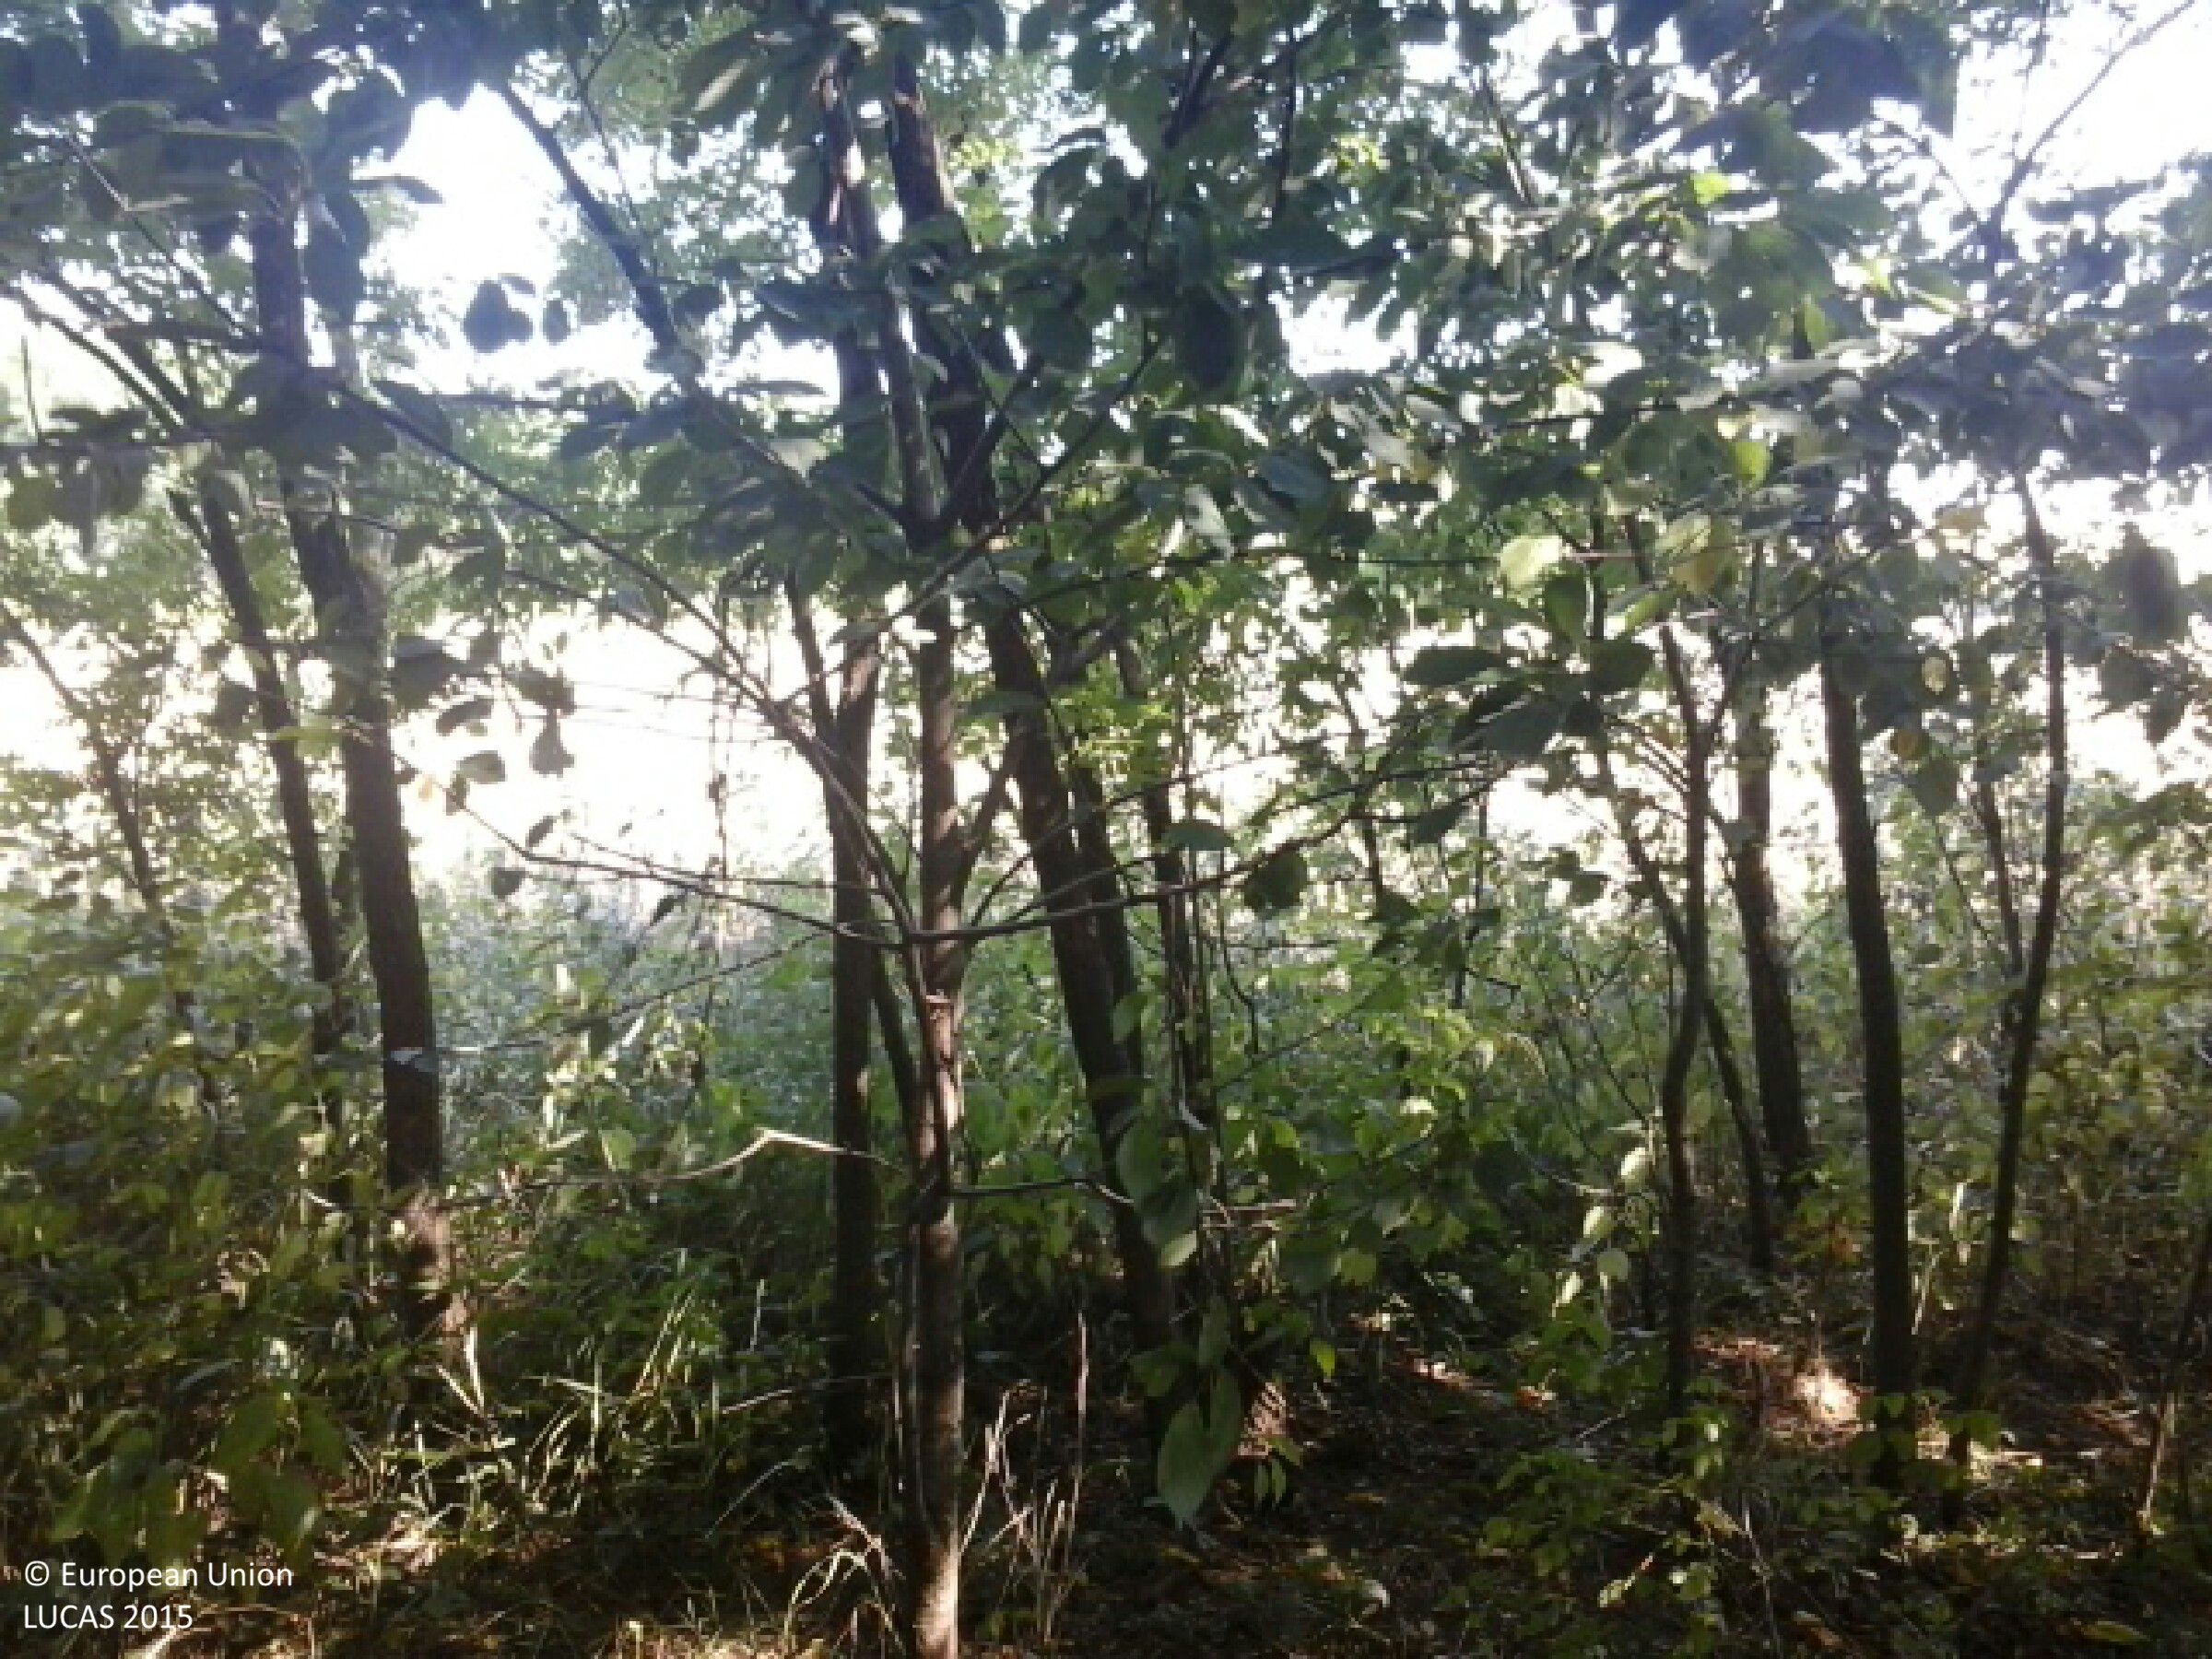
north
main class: Woodland
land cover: Broadleaved woodland
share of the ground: > 75 %
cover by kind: broadleaved forest trees 95 %, shrubs 5 %
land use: Forestry
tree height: < 5 m
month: July
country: HU
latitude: 48.2098
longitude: 21.0618
